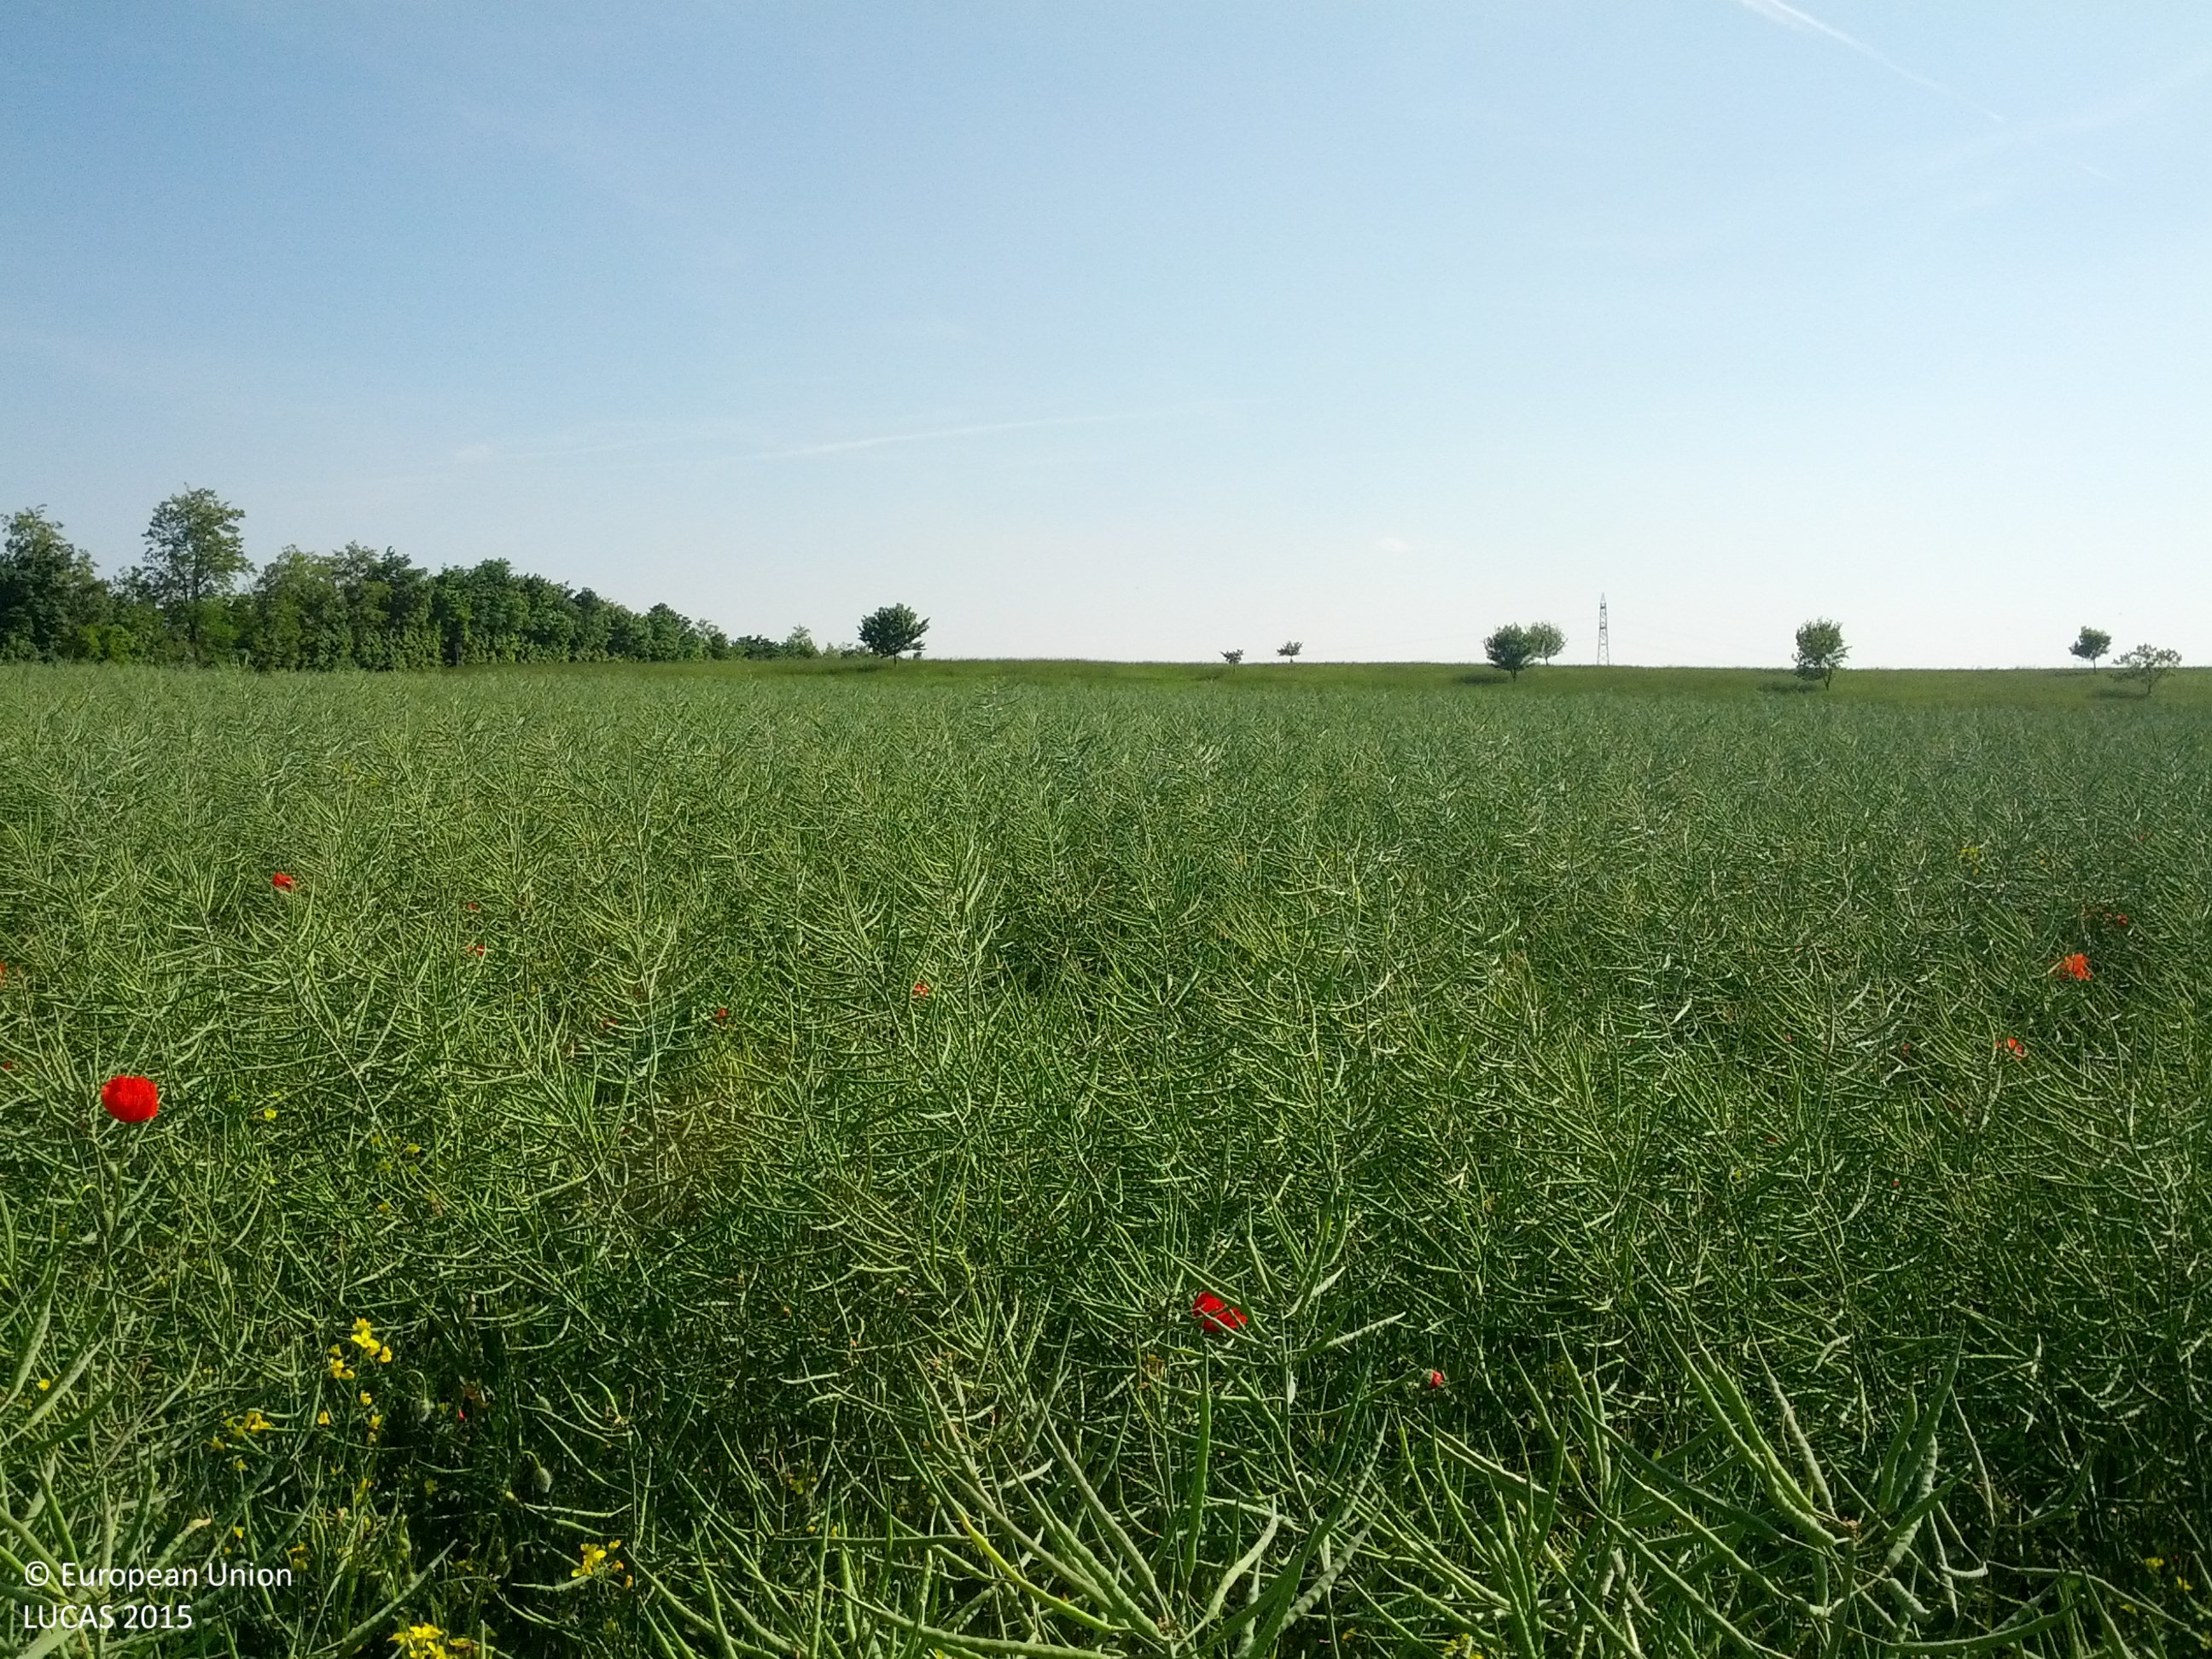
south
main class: Cropland
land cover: Rape and turnip rape
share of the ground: > 75 %
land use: Agriculture (excluding fallow land and kitchen gardens)
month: May
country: AT
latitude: 48.0573
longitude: 16.6743
